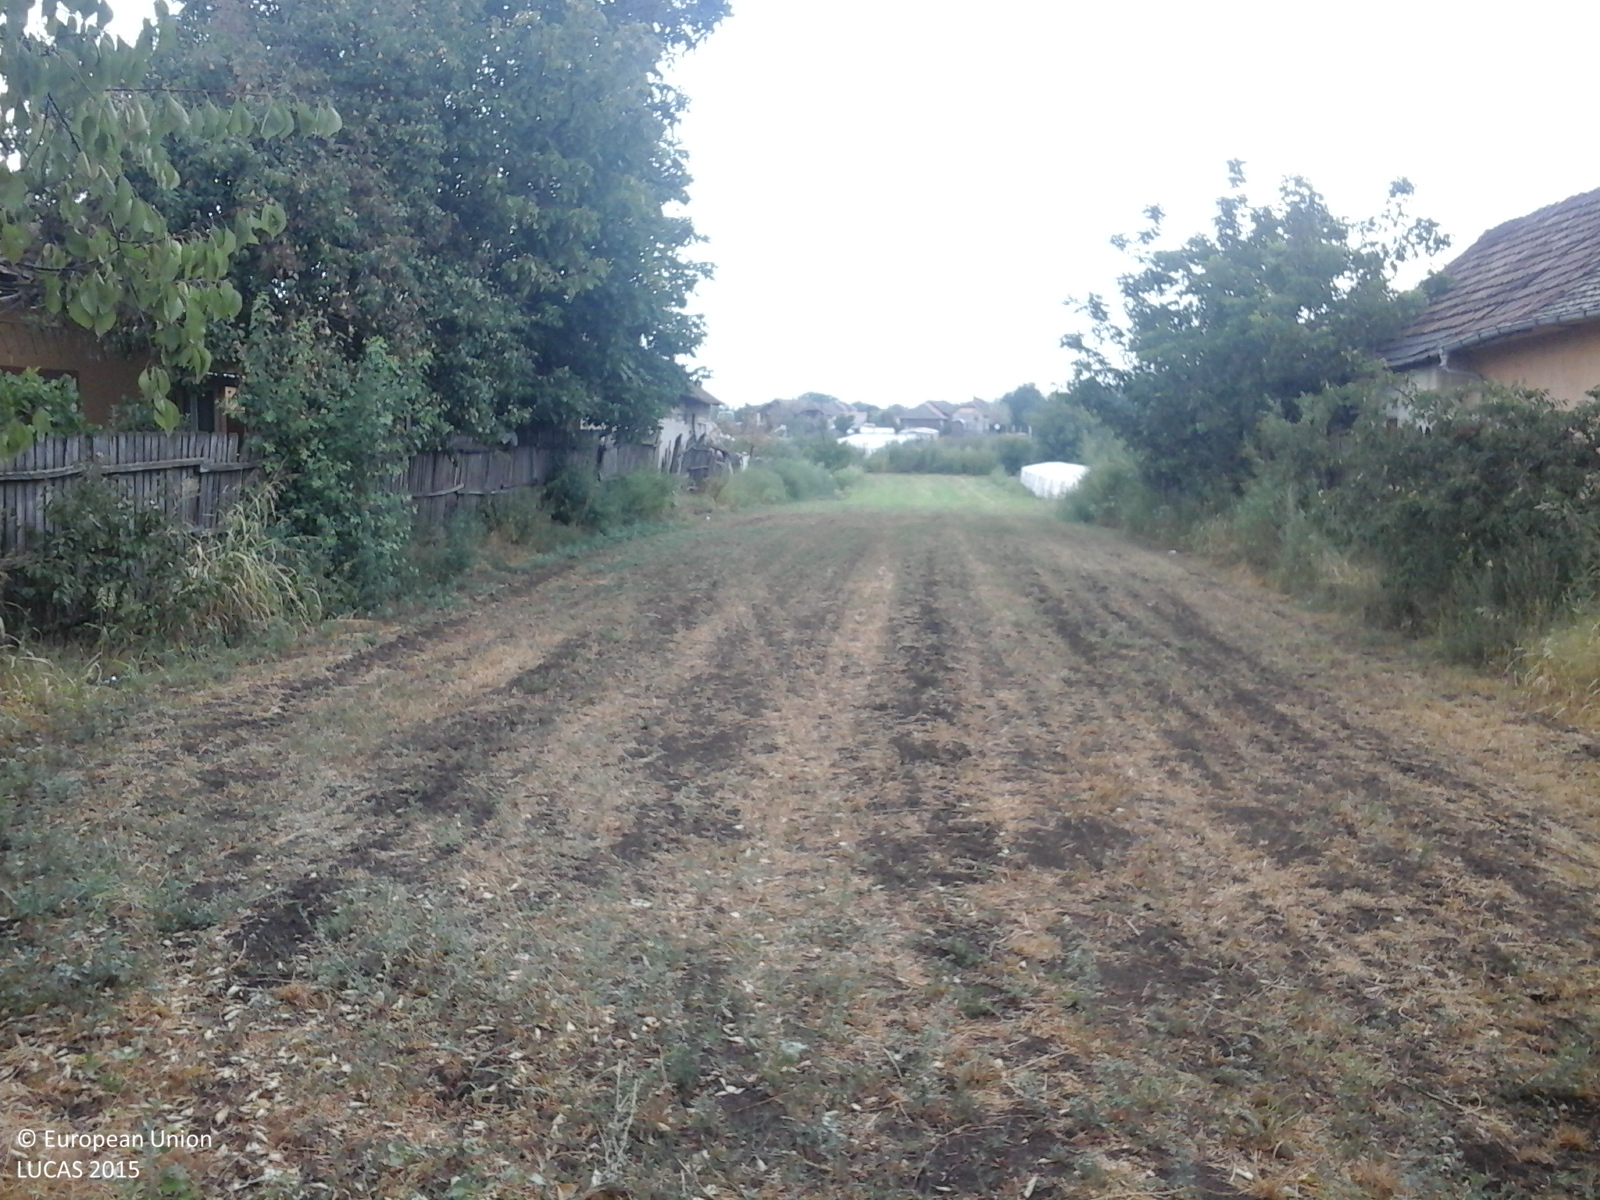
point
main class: Cropland
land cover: Other leguminous and mixtures for fodder
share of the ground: > 75 %
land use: Kitchen garden
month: August
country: RO
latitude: 43.9263
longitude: 23.0324
